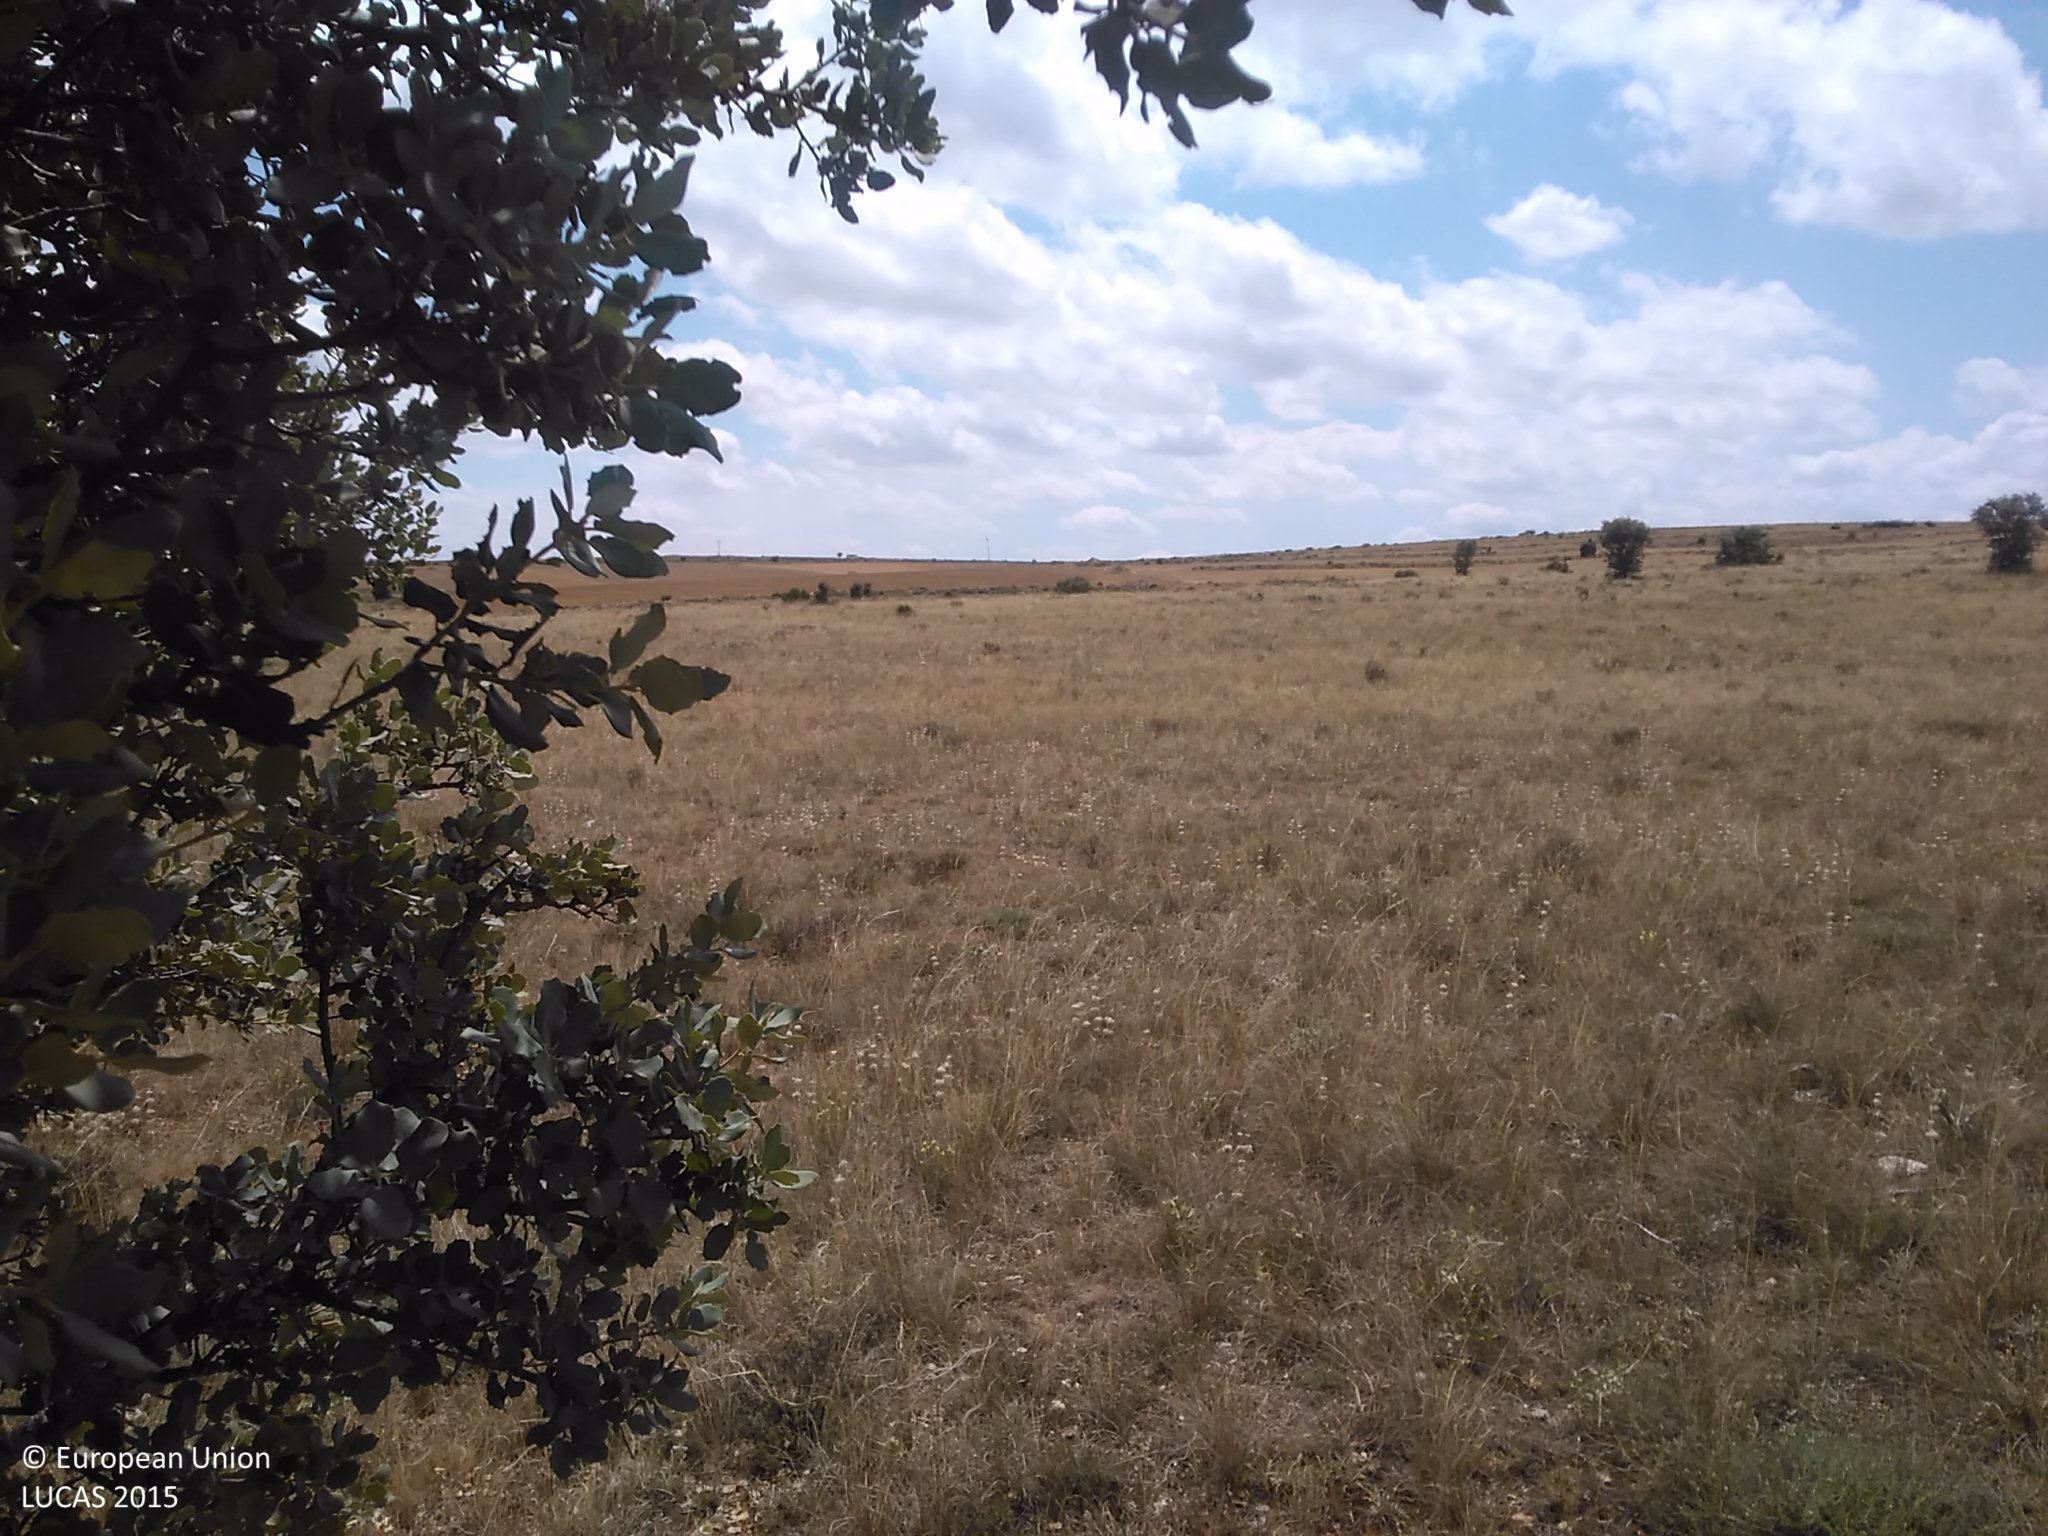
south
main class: Grassland
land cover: Grassland with sparse tree/shrub cover
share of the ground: 10 - 25 %
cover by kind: herbaceous plants 70 %, unconsolidated bare surface 20 %, broadleaved forest trees 5 %, shrubs 5 %
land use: Semi-natural and natural areas not in use
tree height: < 5 m
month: July
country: ES
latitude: 41.7741
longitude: -2.2950
